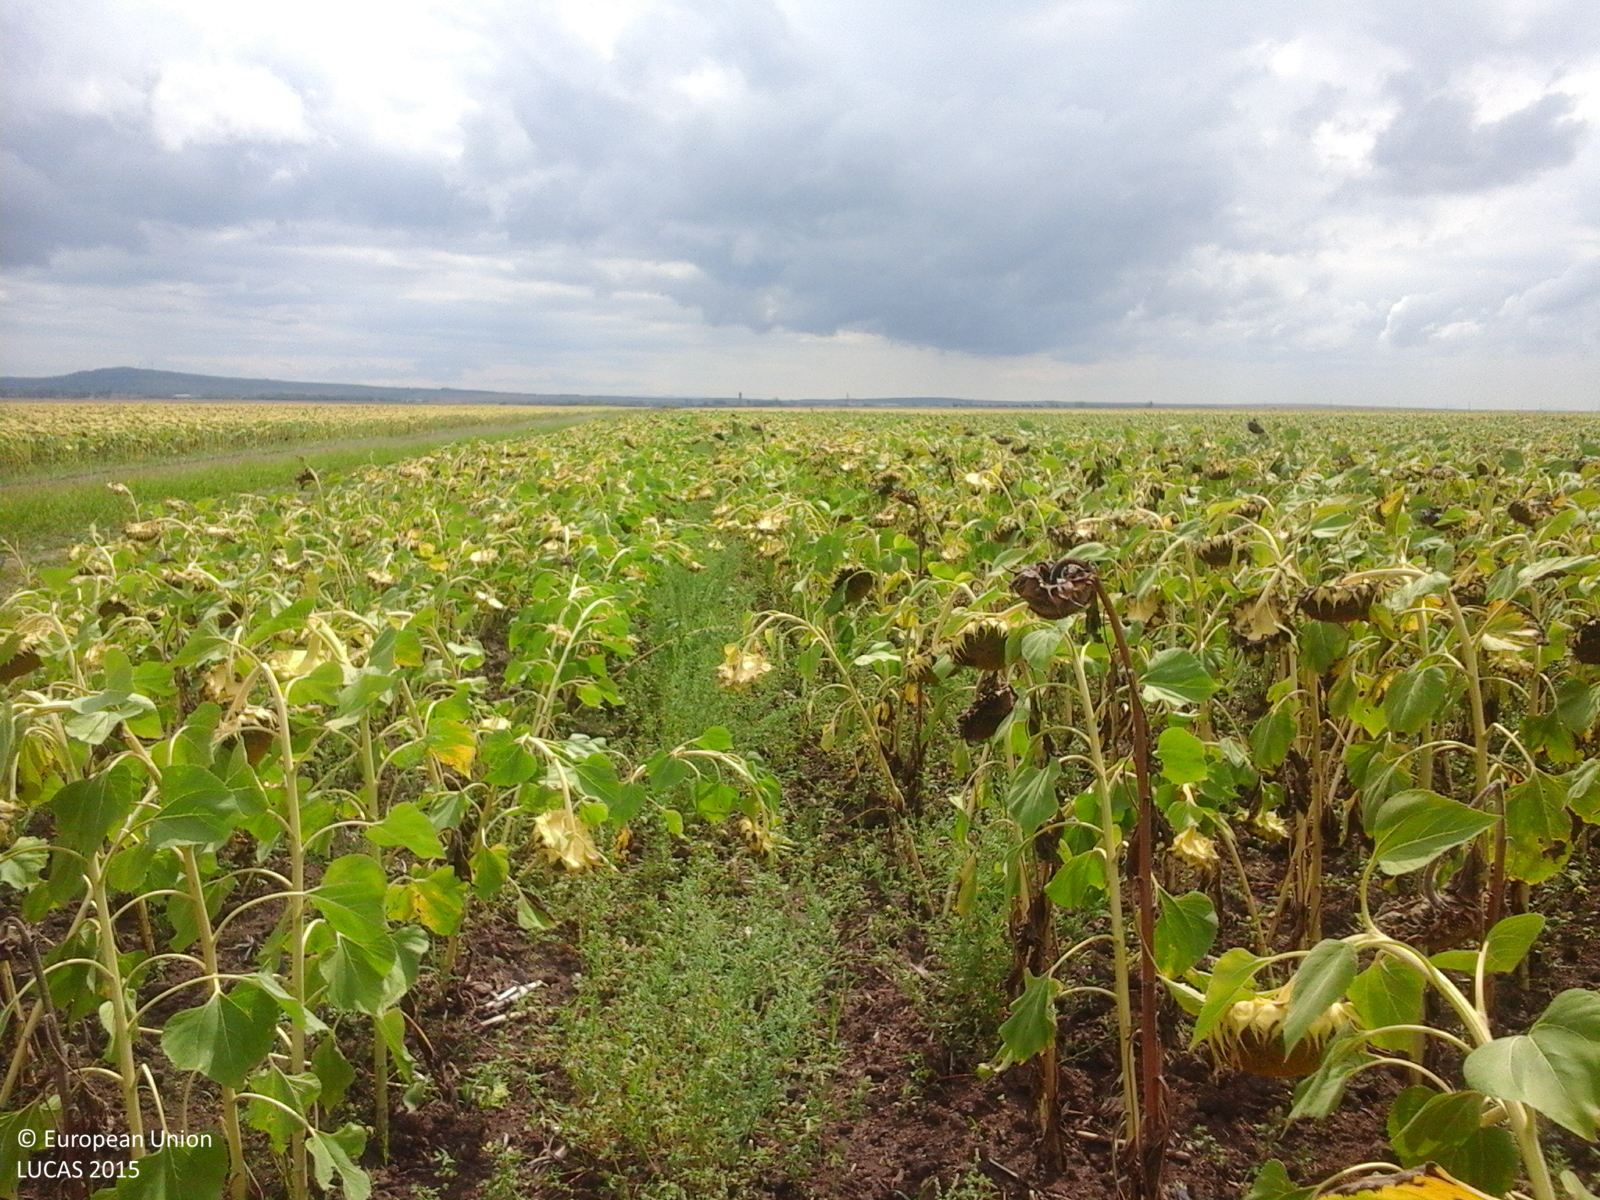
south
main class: Cropland
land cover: Sunflower
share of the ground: > 75 %
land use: Agriculture (excluding fallow land and kitchen gardens)
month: August
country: RO
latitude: 45.6839
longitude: 21.5770
